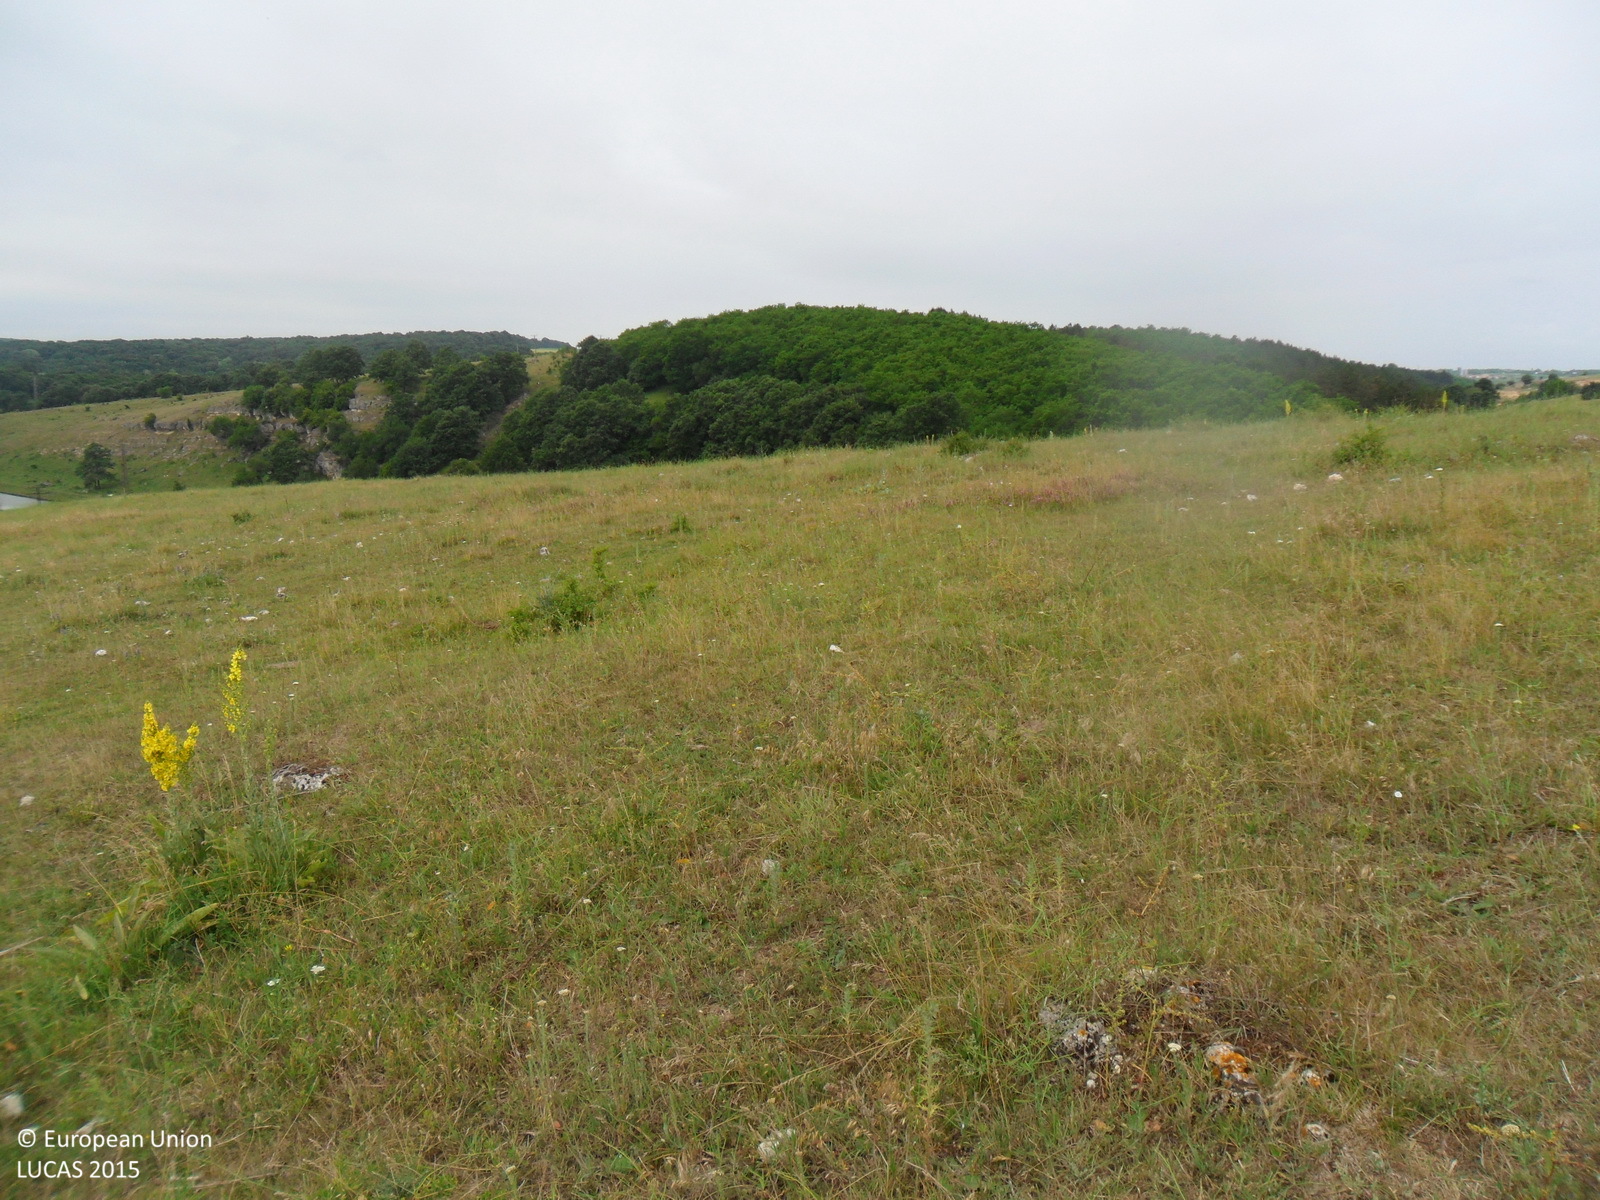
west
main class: Grassland
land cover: Grassland without tree/shrub cover
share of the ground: > 75 %
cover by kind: herbaceous plants 100 %
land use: Agriculture (excluding fallow land and kitchen gardens)
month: June
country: BG
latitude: 43.7373
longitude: 26.7132
